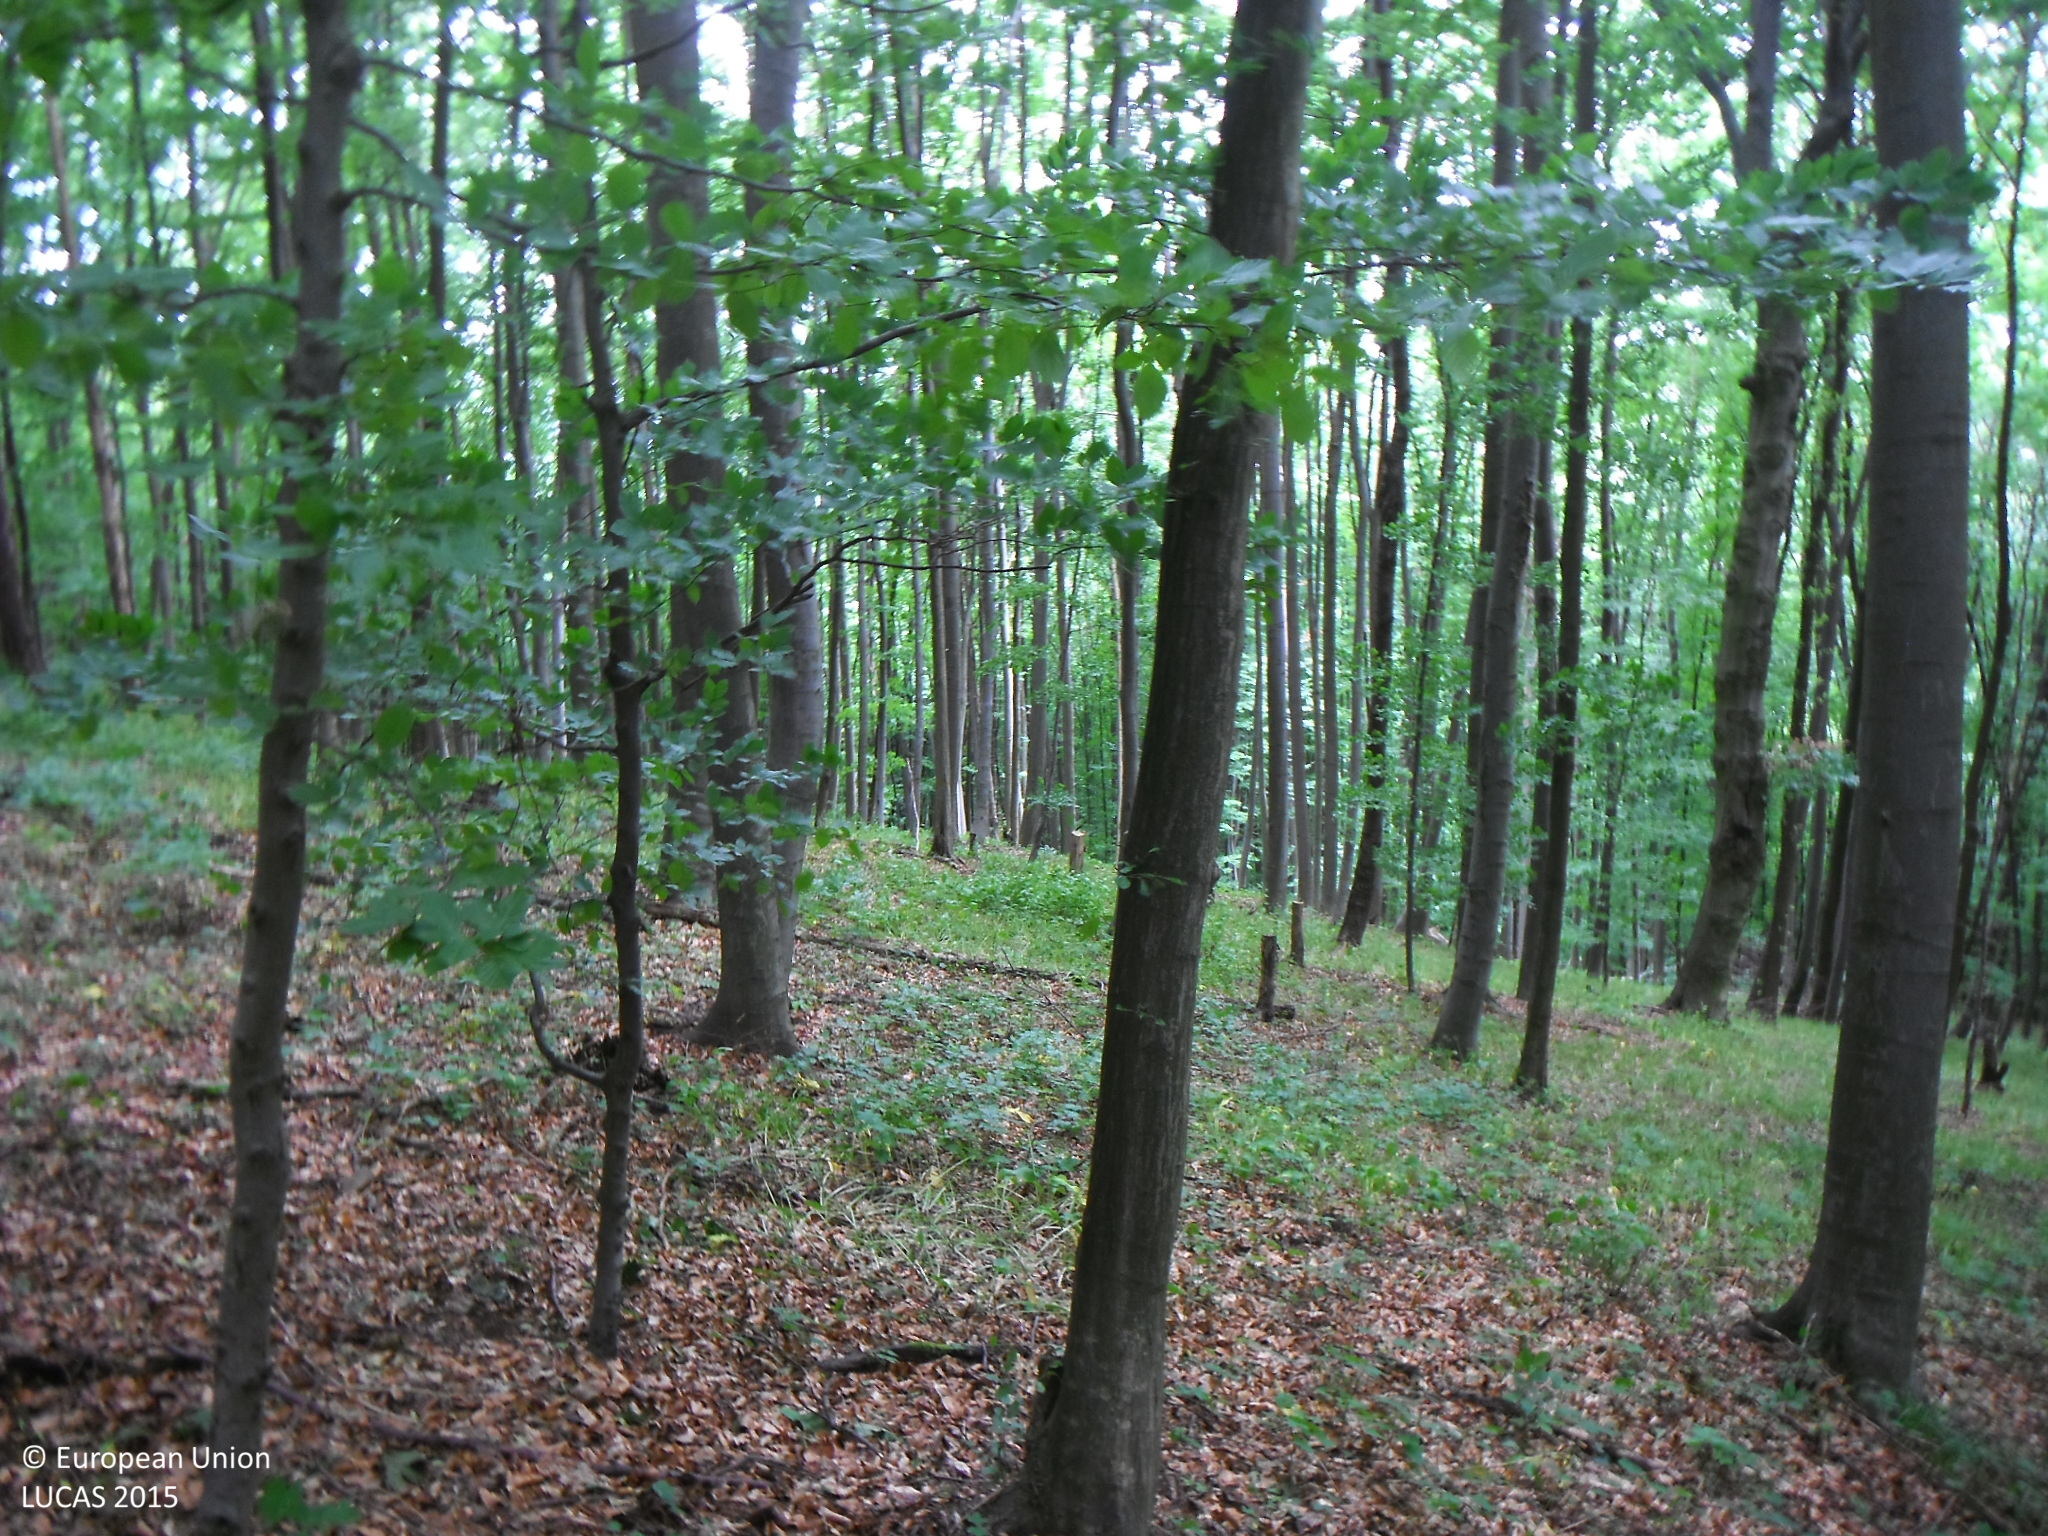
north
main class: Woodland
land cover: Broadleaved woodland
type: beech forest
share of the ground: > 75 %
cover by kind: broadleaved forest trees 100 %
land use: Forestry
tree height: > 5 m
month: June
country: SK
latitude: 49.1677
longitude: 21.6400
